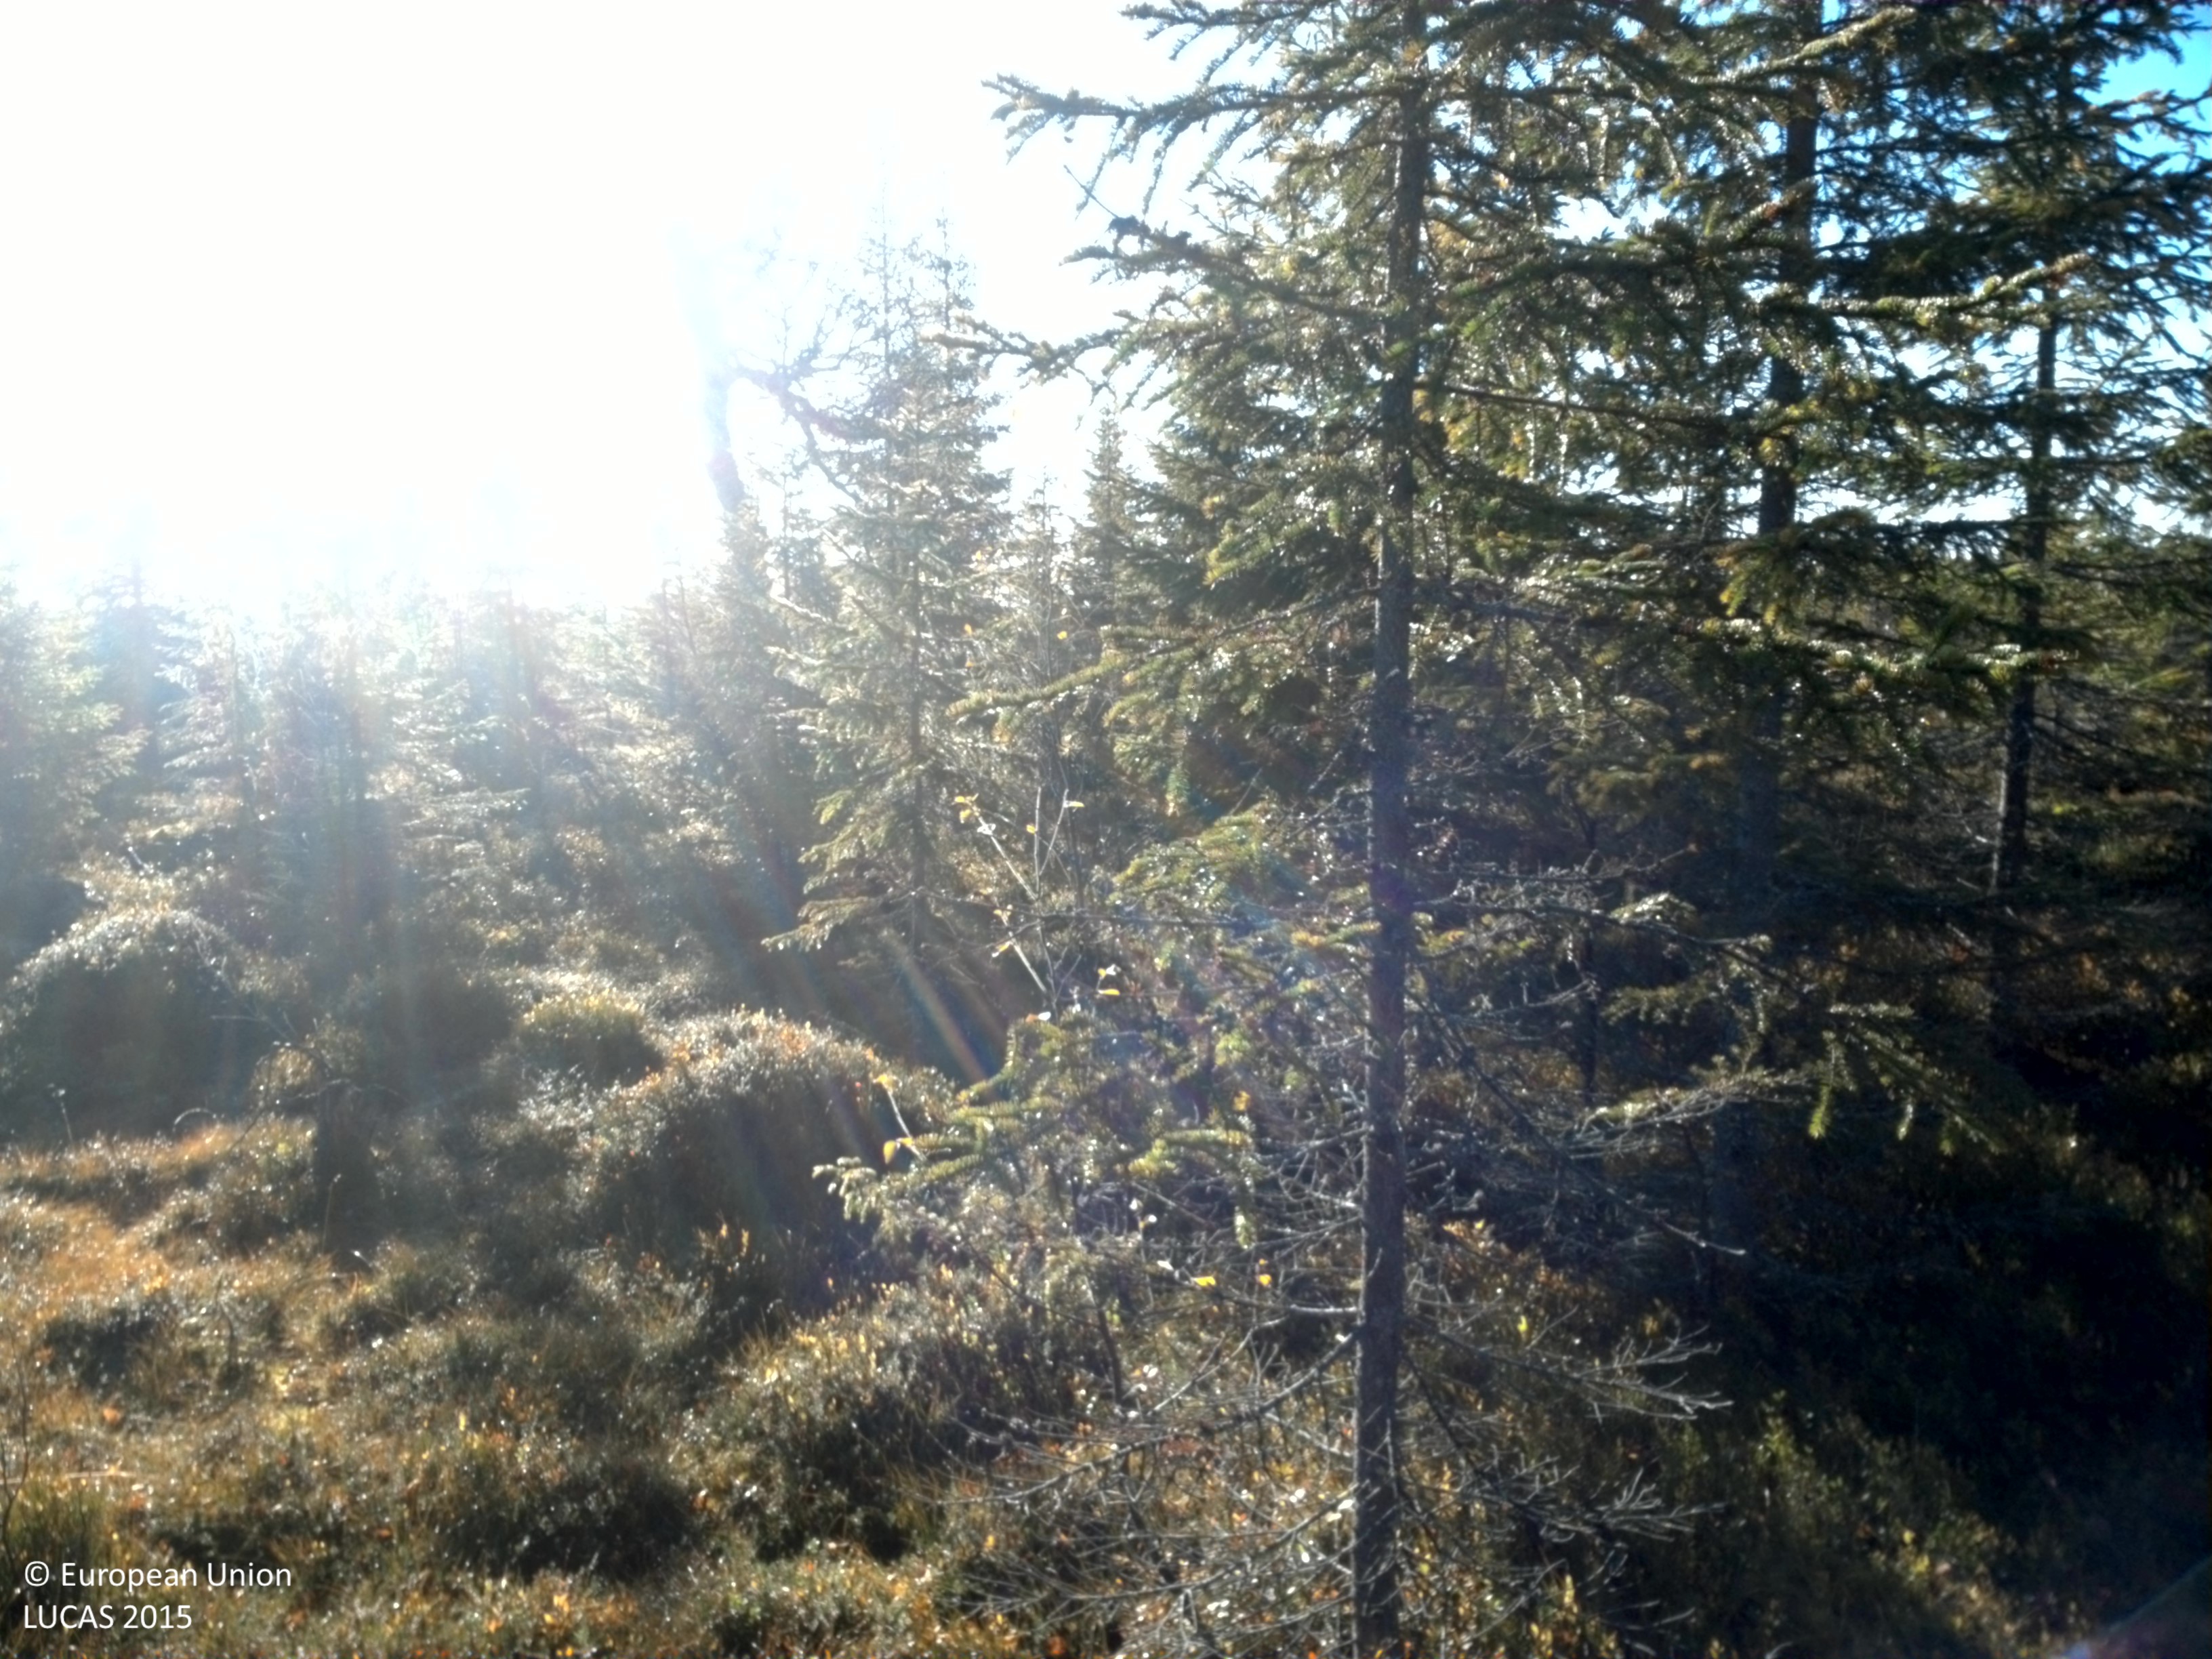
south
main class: Woodland
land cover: Spruce dominated coniferous woodland
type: boreal forest
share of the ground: 10 - 25 %
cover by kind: shrubs 65 %, coniferous forest trees 15 %, herbaceous plants 10 %, lichens and mosses 10 %
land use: Forestry
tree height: < 5 m
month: October
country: SE
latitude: 64.8645
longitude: 16.9068
